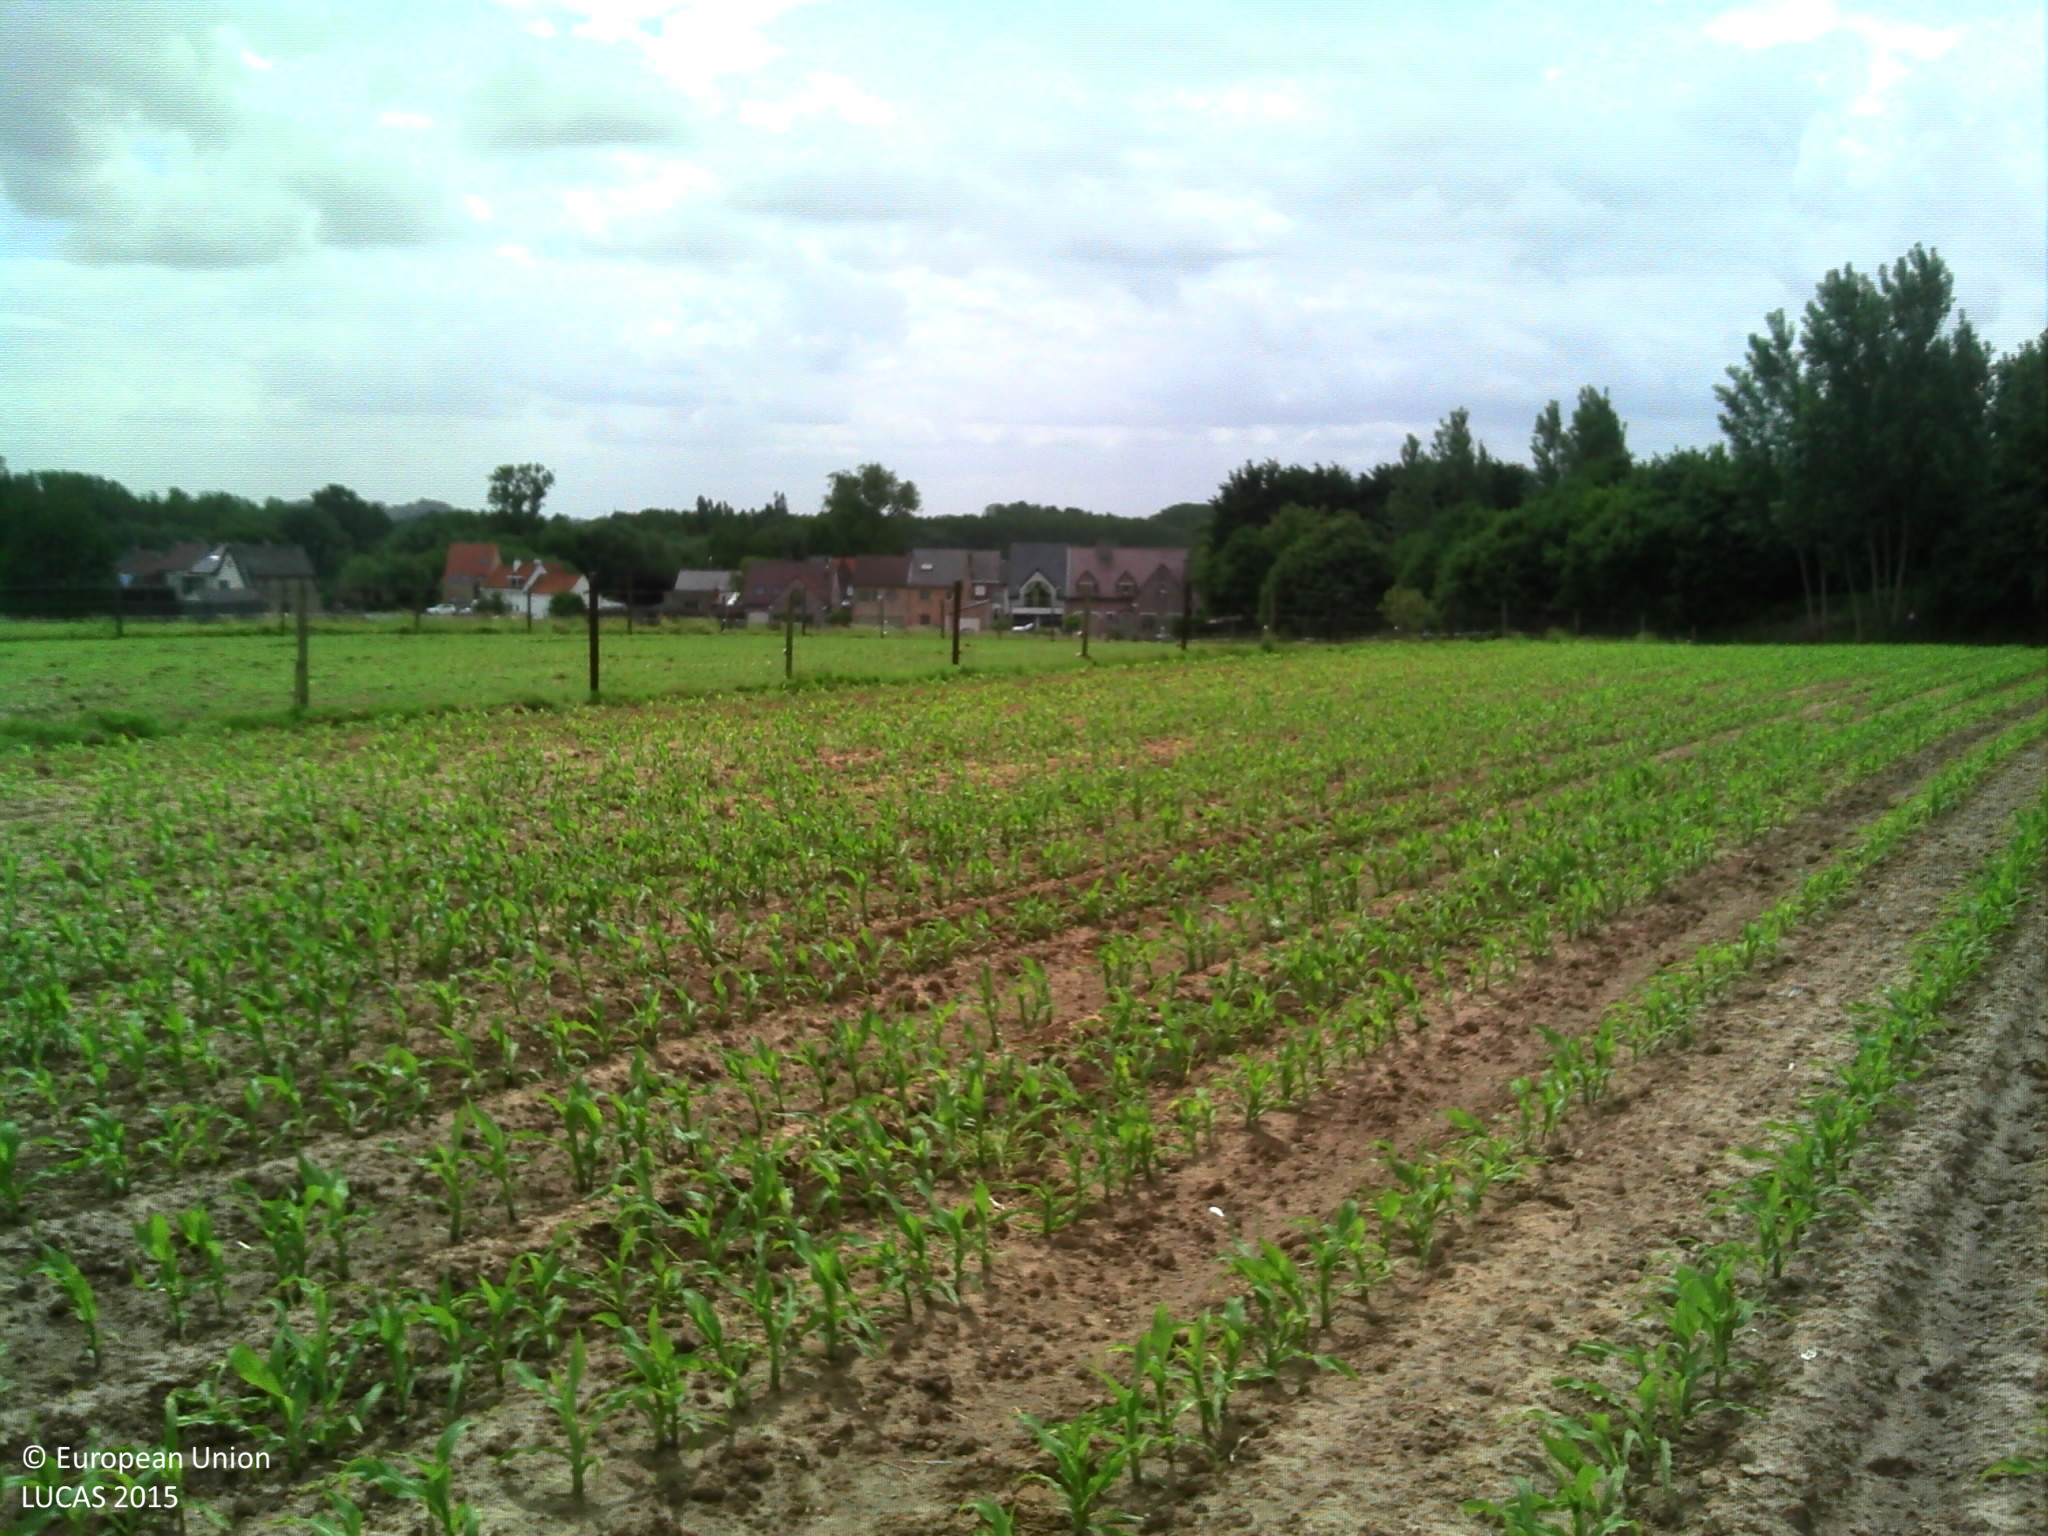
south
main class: Cropland
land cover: Maize
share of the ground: 25 - 50 %
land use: Agriculture (excluding fallow land and kitchen gardens)
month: June
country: BE
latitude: 50.8757
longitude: 4.0396
